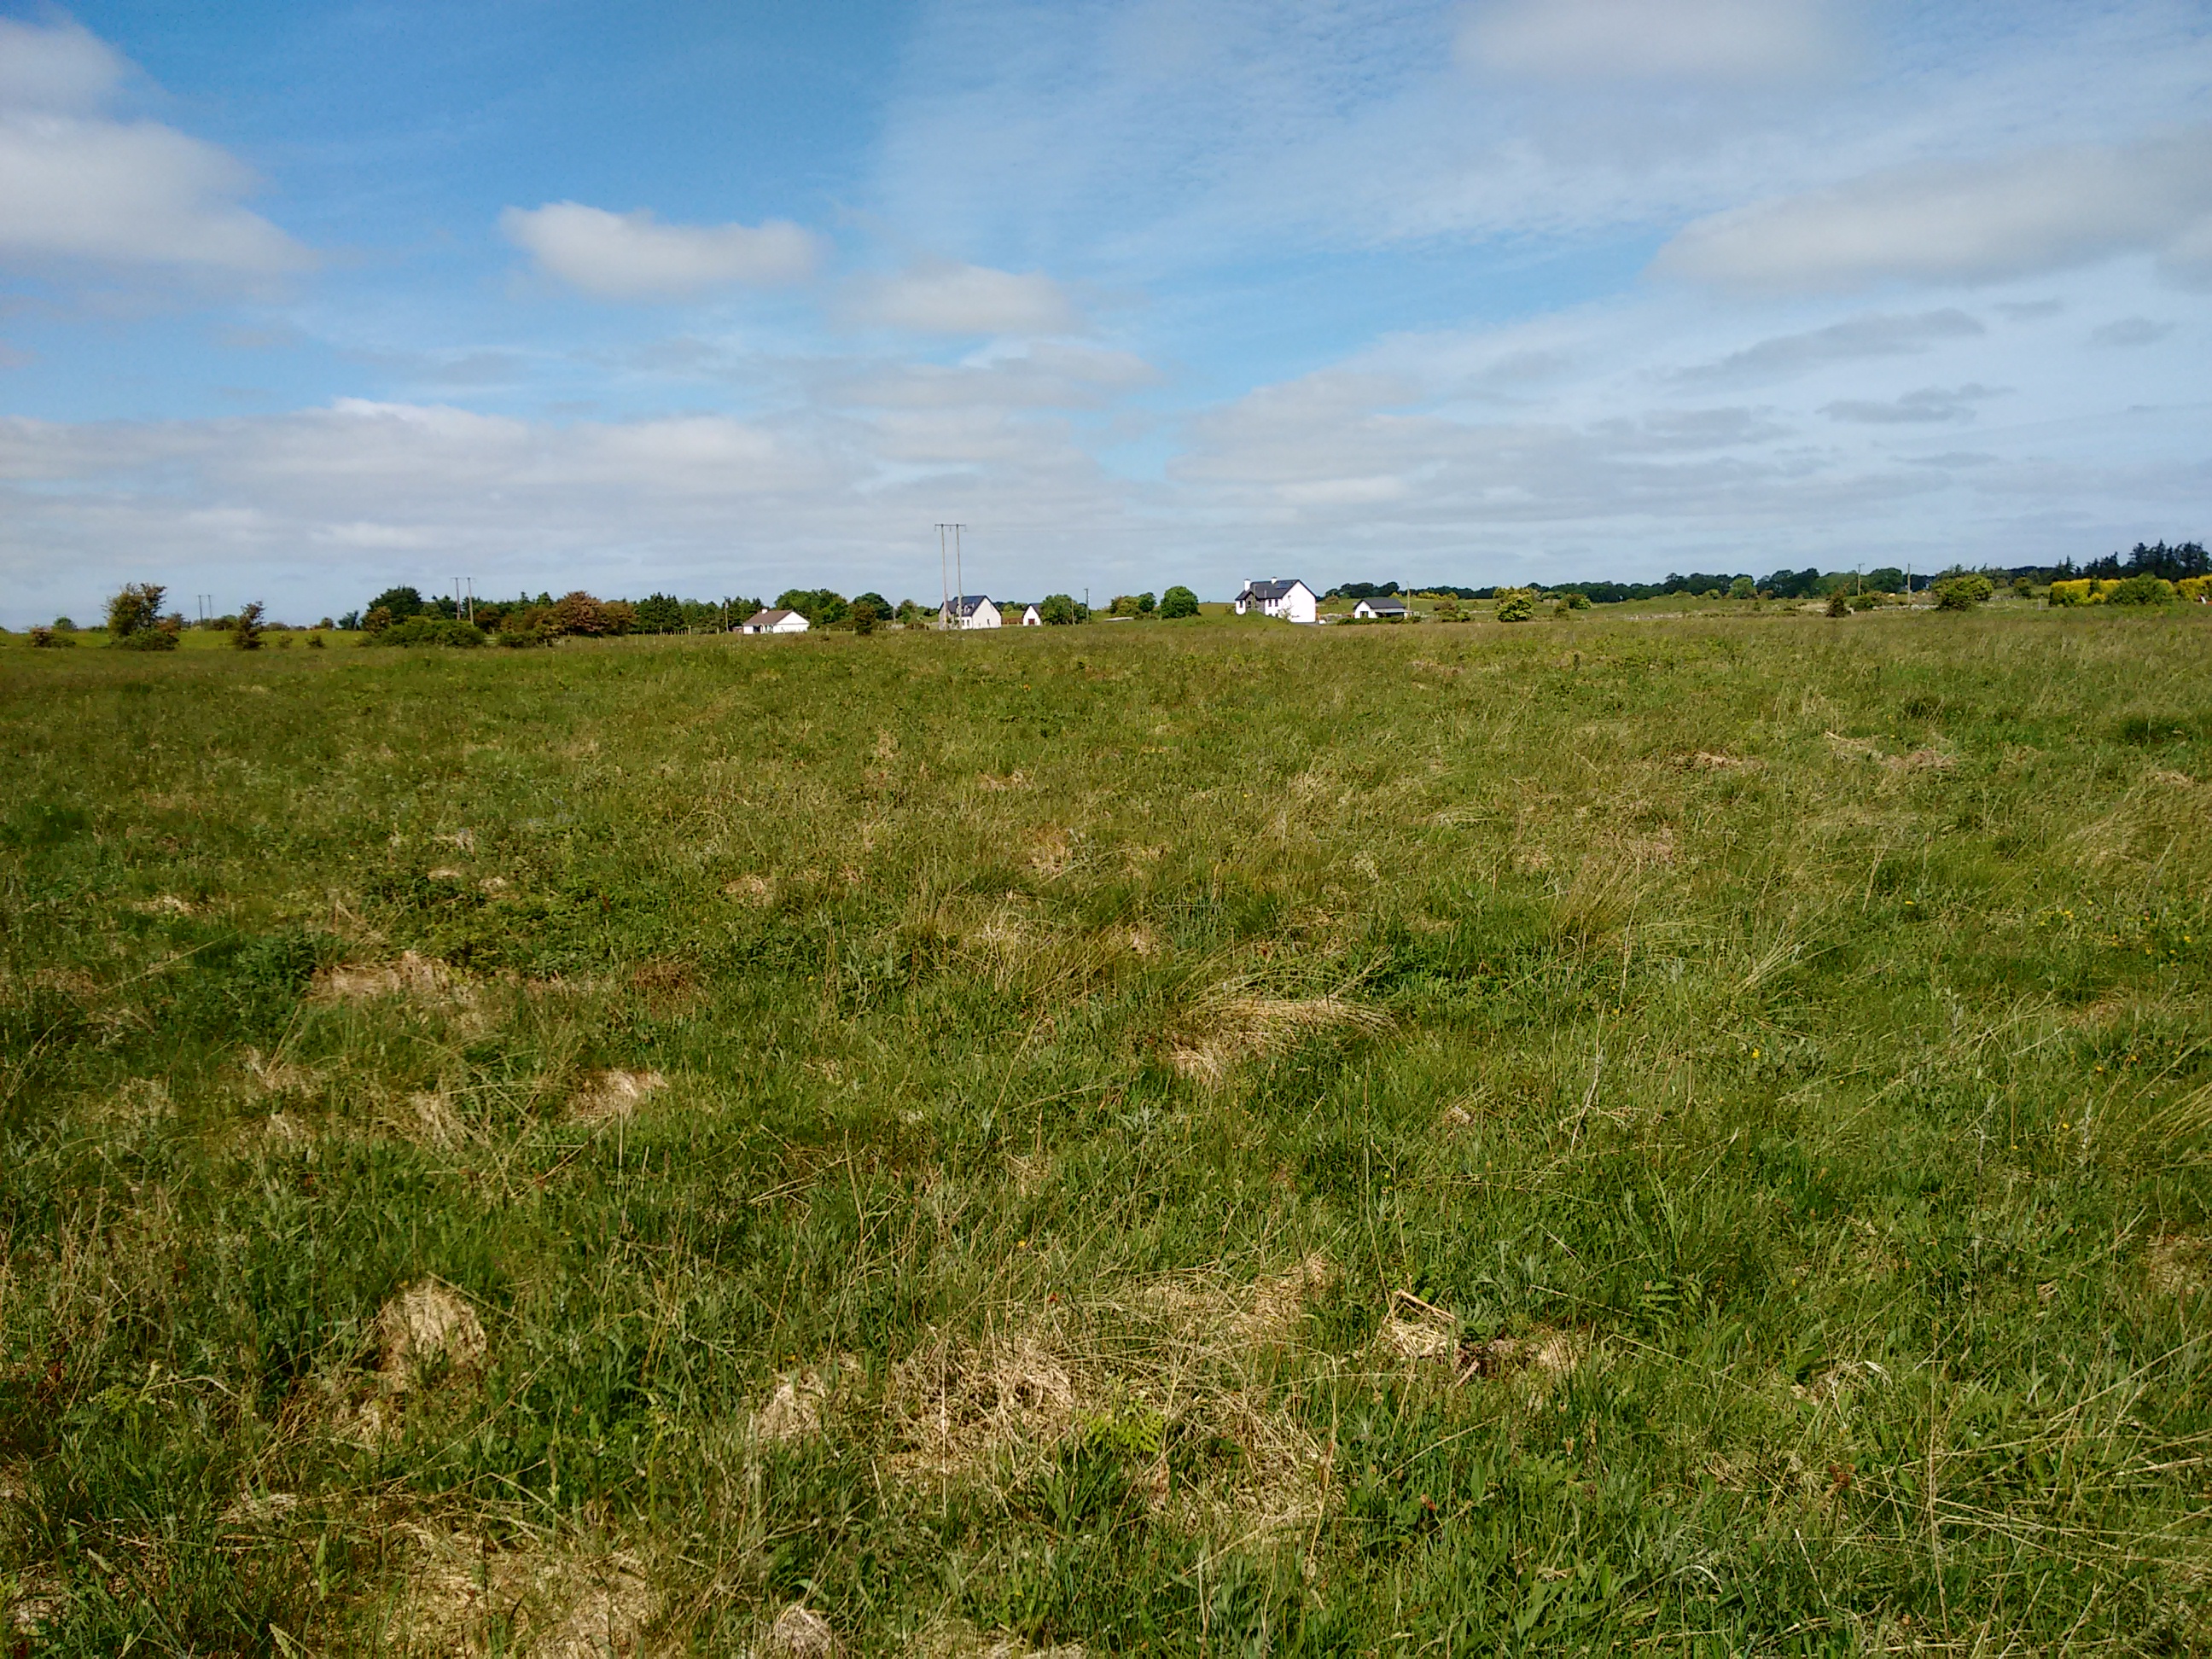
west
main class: Grassland
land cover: Grassland without tree/shrub cover
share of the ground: > 75 %
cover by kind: herbaceous plants 100 %
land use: Agriculture (excluding fallow land and kitchen gardens)
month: June
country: IE
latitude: 53.2258
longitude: -8.5444
